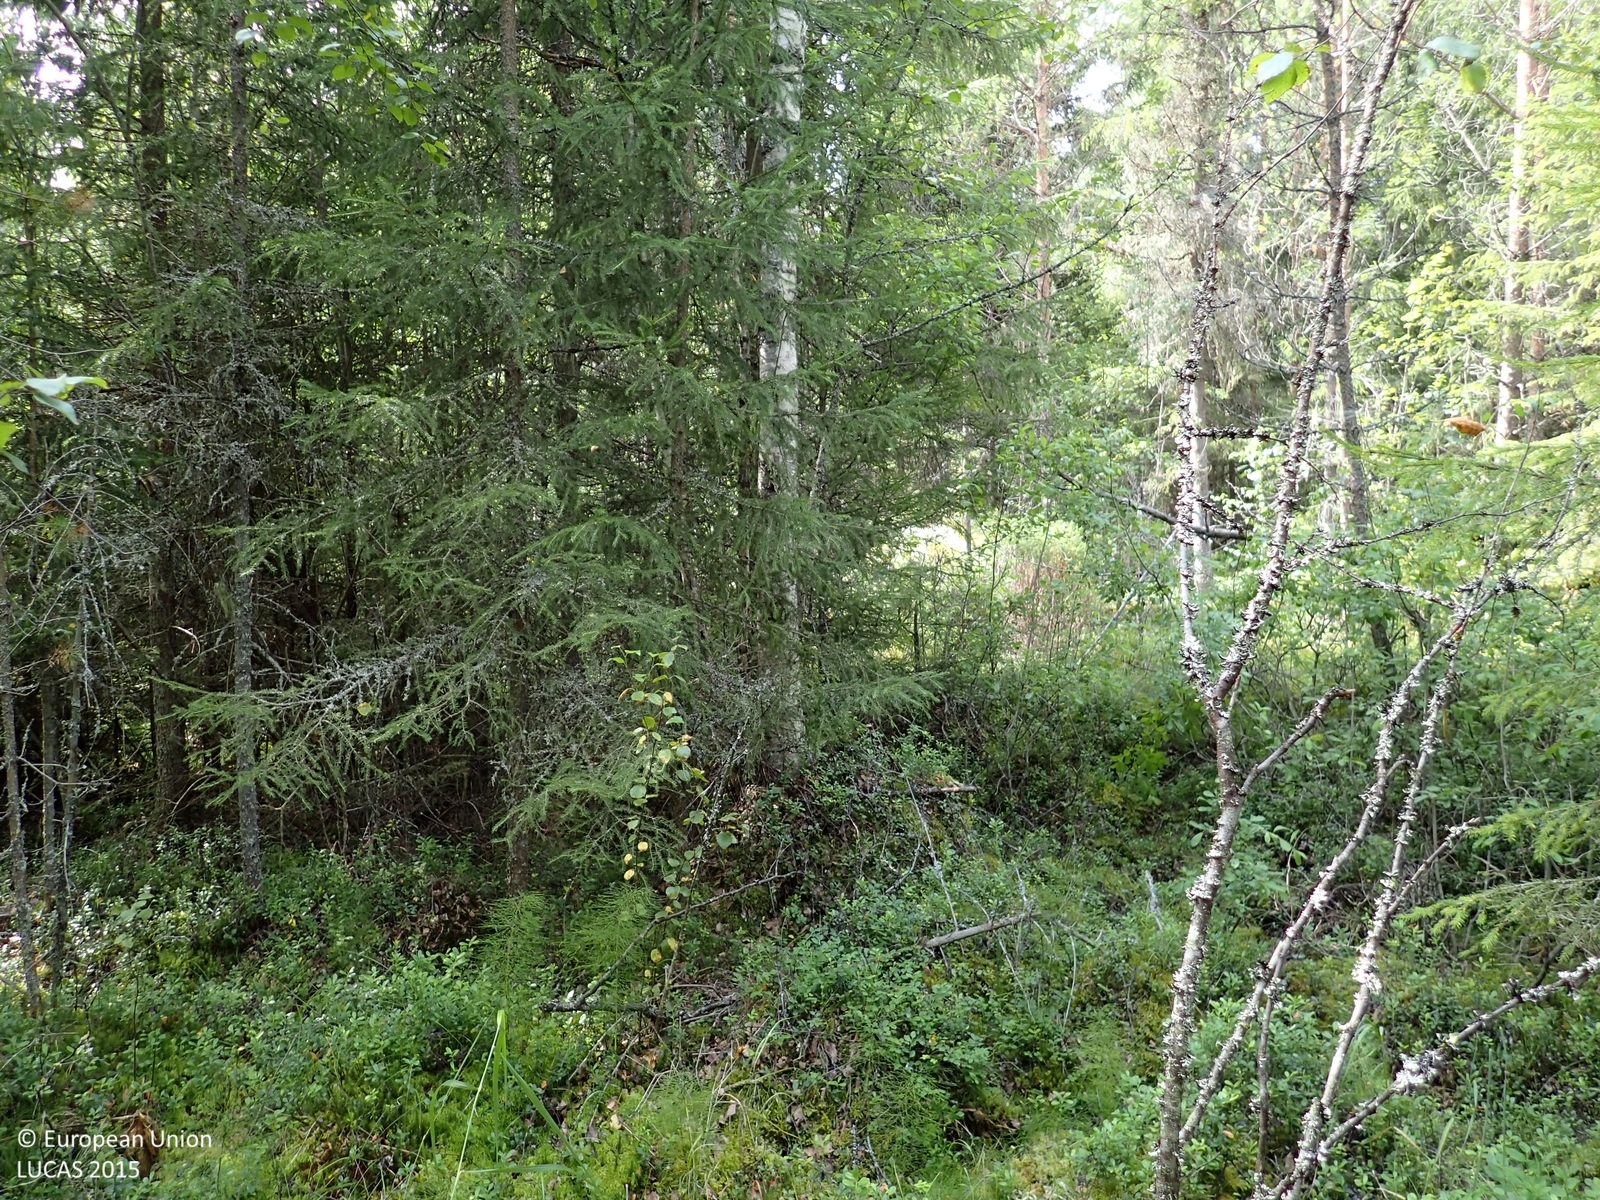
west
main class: Woodland
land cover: Spruce dominated mixed woodland
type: boreal forest
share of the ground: > 75 %
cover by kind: broadleaved forest trees 60 %, coniferous forest trees 25 %, shrubs 10 %, herbaceous plants 5 %
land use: Forestry
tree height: > 5 m
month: August
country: FI
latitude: 62.8521
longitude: 21.8907
